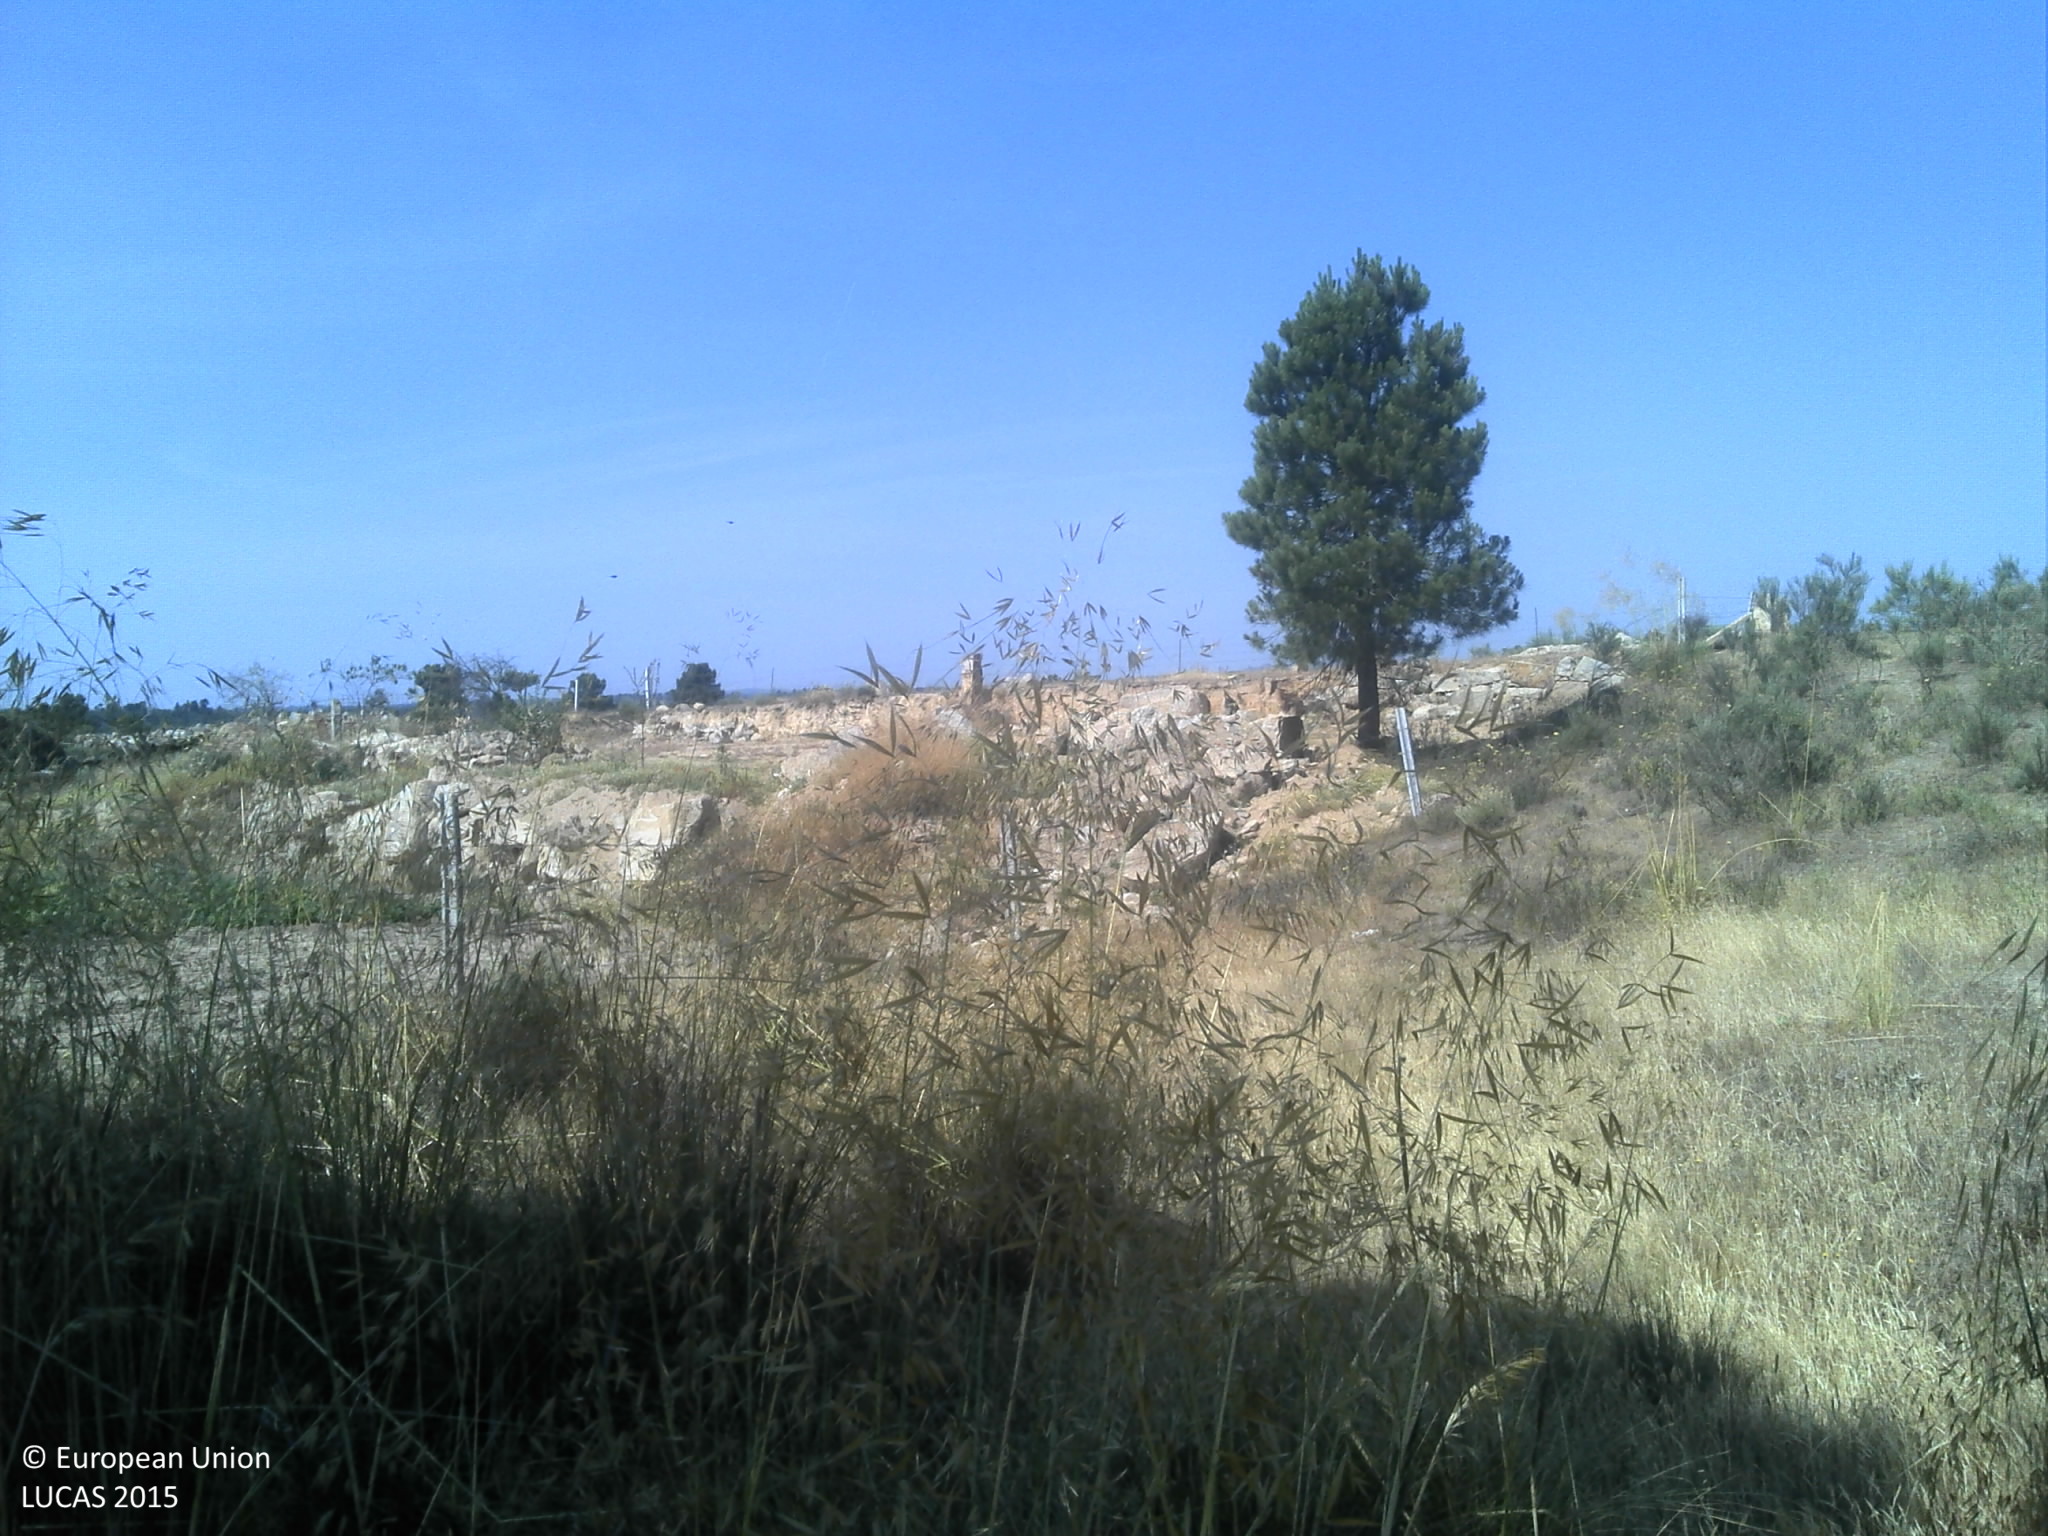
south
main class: Shrubland
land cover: Shrubland with sparse tree cover
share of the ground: 50 - 75 %
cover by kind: shrubs 70 %, unconsolidated bare surface 15 %, herbaceous plants 10 %, broadleaved forest trees 5 %
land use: Semi-natural and natural areas not in use
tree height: < 5 m
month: June
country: PT
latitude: 40.4365
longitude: -6.9666
